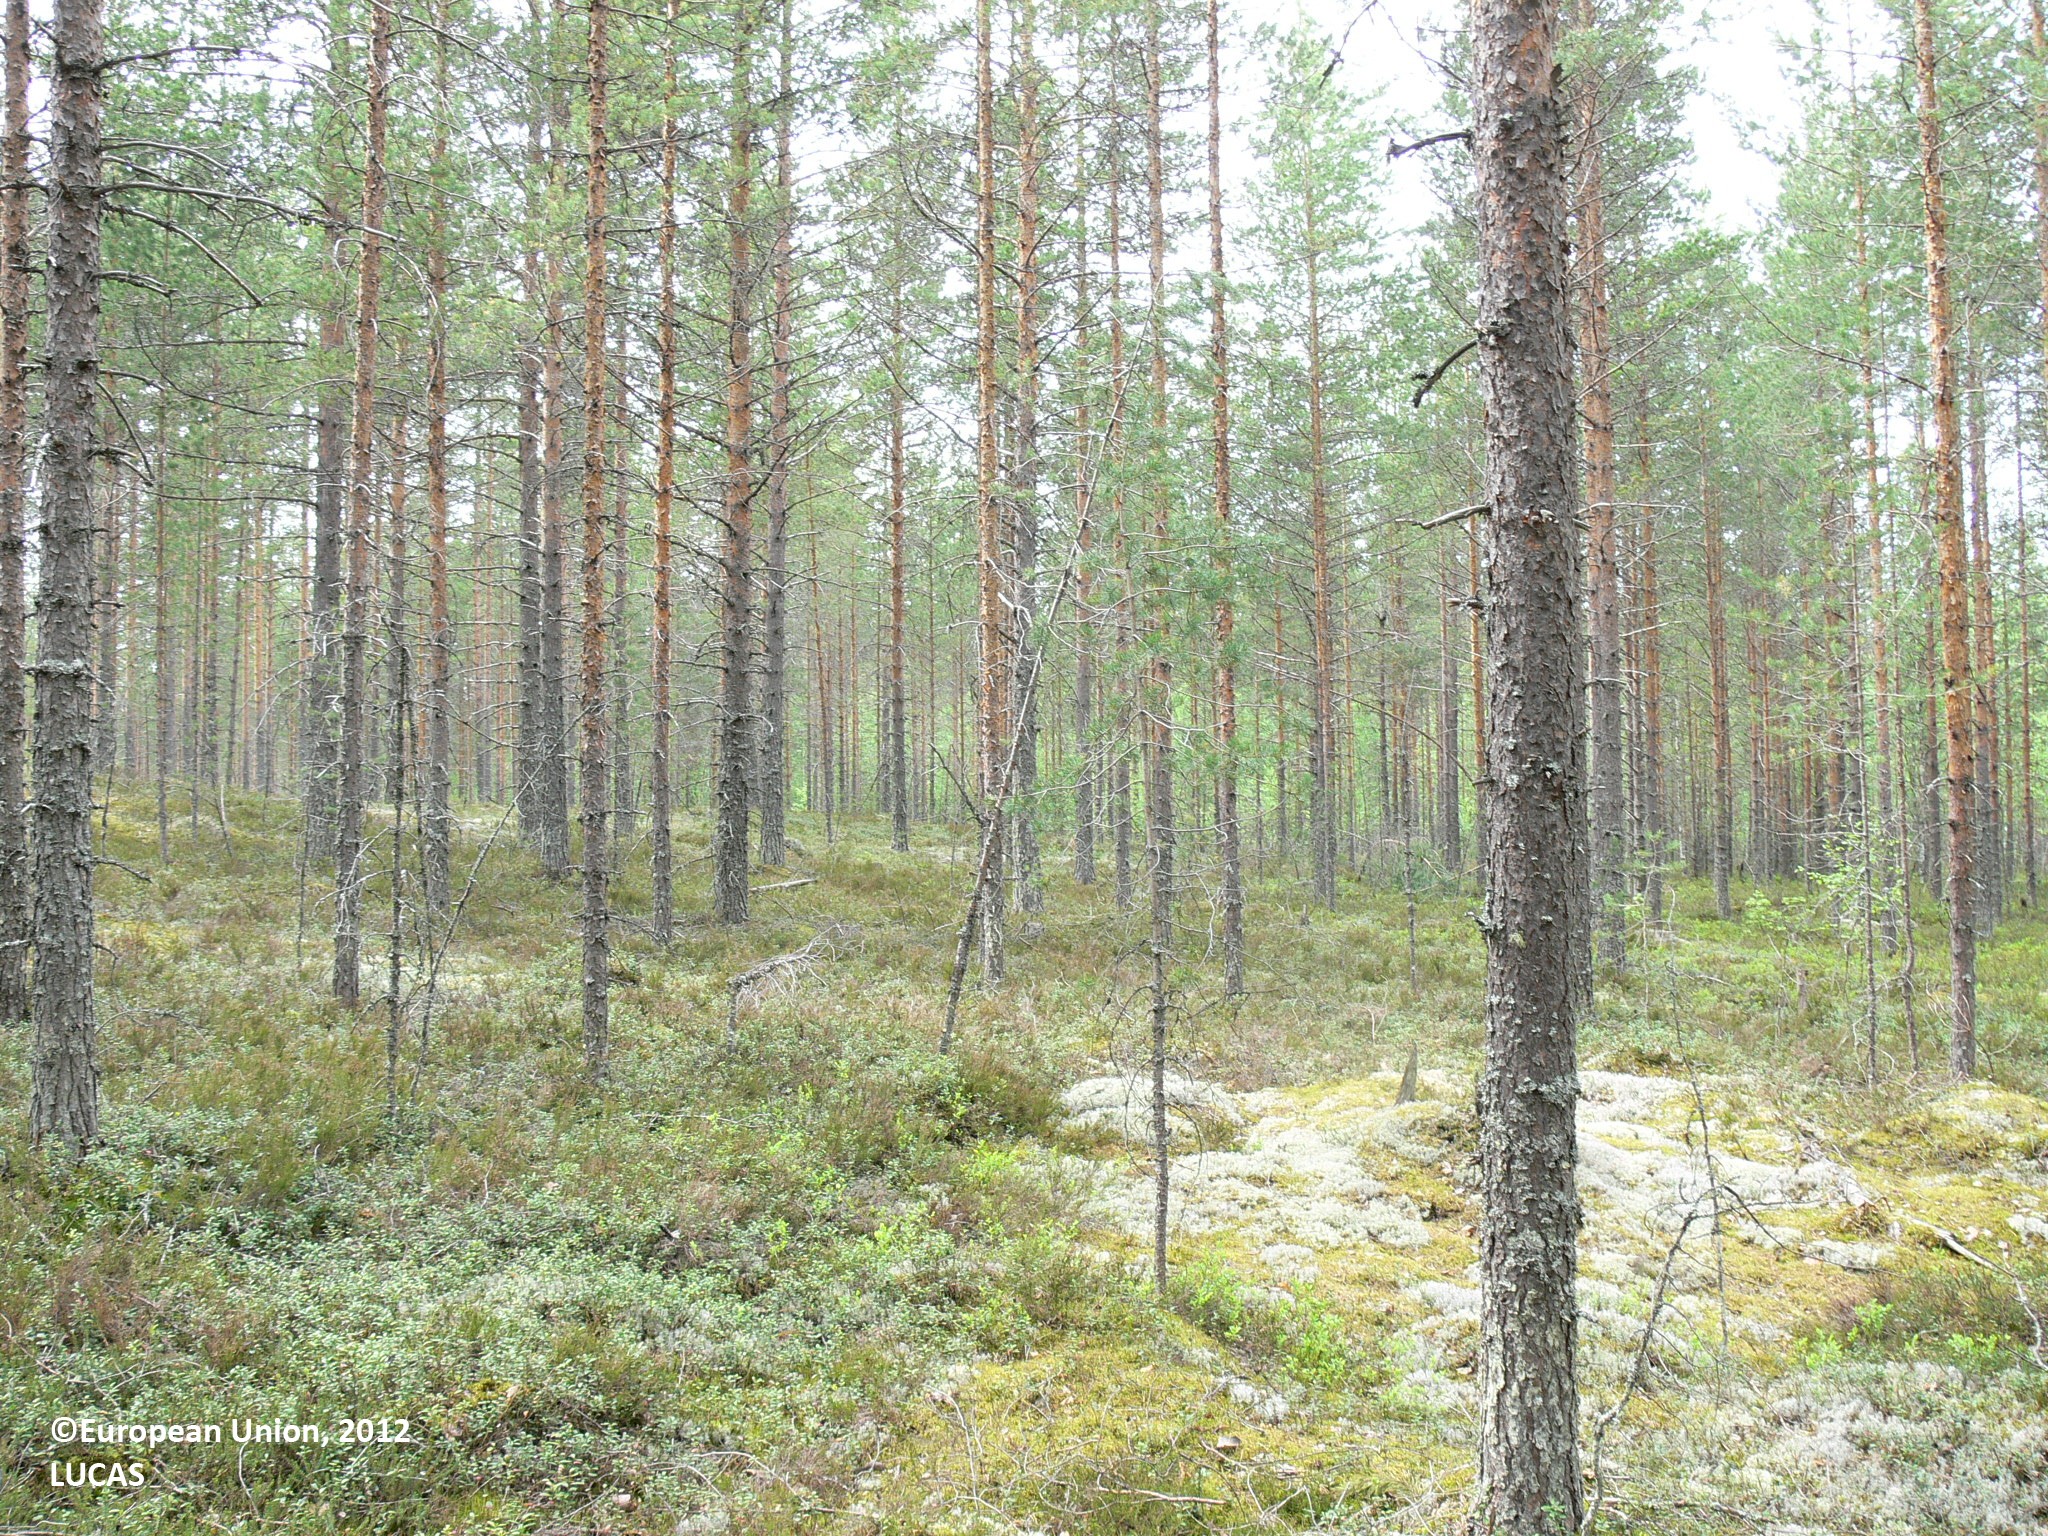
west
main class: Woodland
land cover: Pine dominated coniferous woodland
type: boreal forest
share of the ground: > 75 %
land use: Forestry
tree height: > 5 m
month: June
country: FI
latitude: 62.2713
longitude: 30.1716
